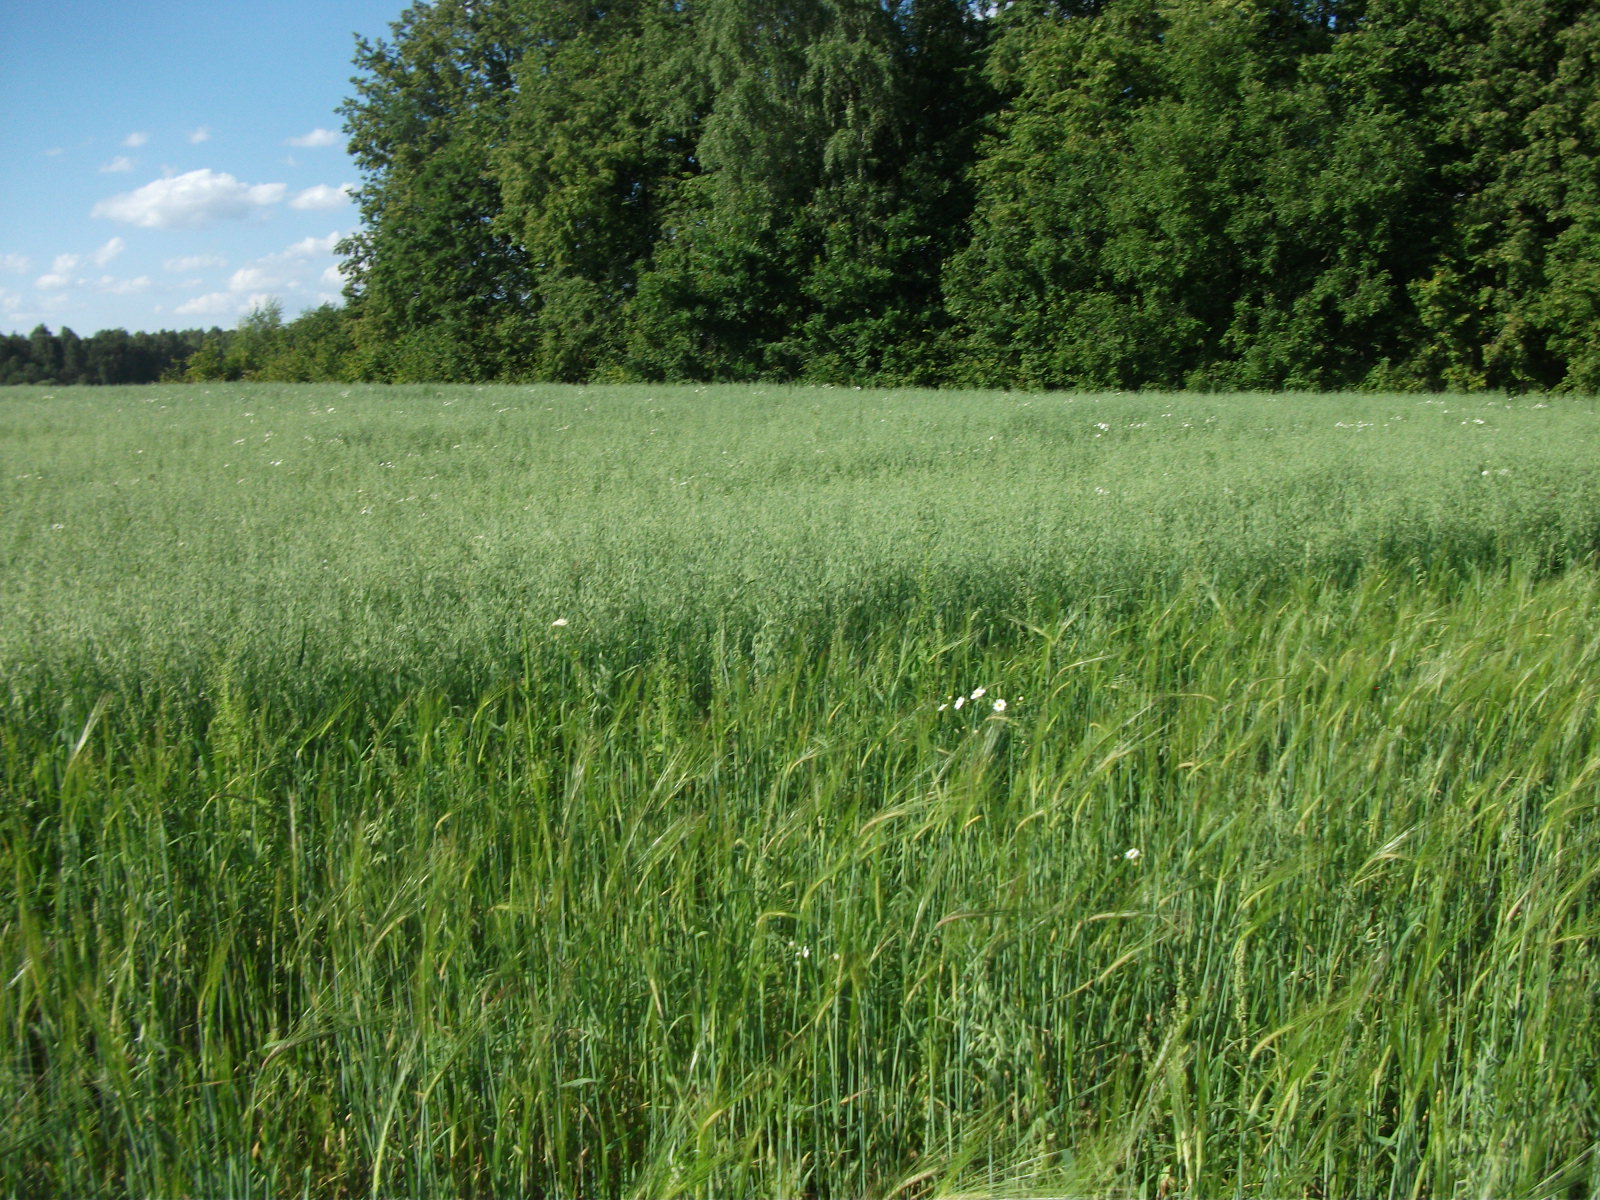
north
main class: Cropland
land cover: Barley
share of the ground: > 75 %
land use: Agriculture (excluding fallow land and kitchen gardens)
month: August
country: LV
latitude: 57.0449
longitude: 26.6146
